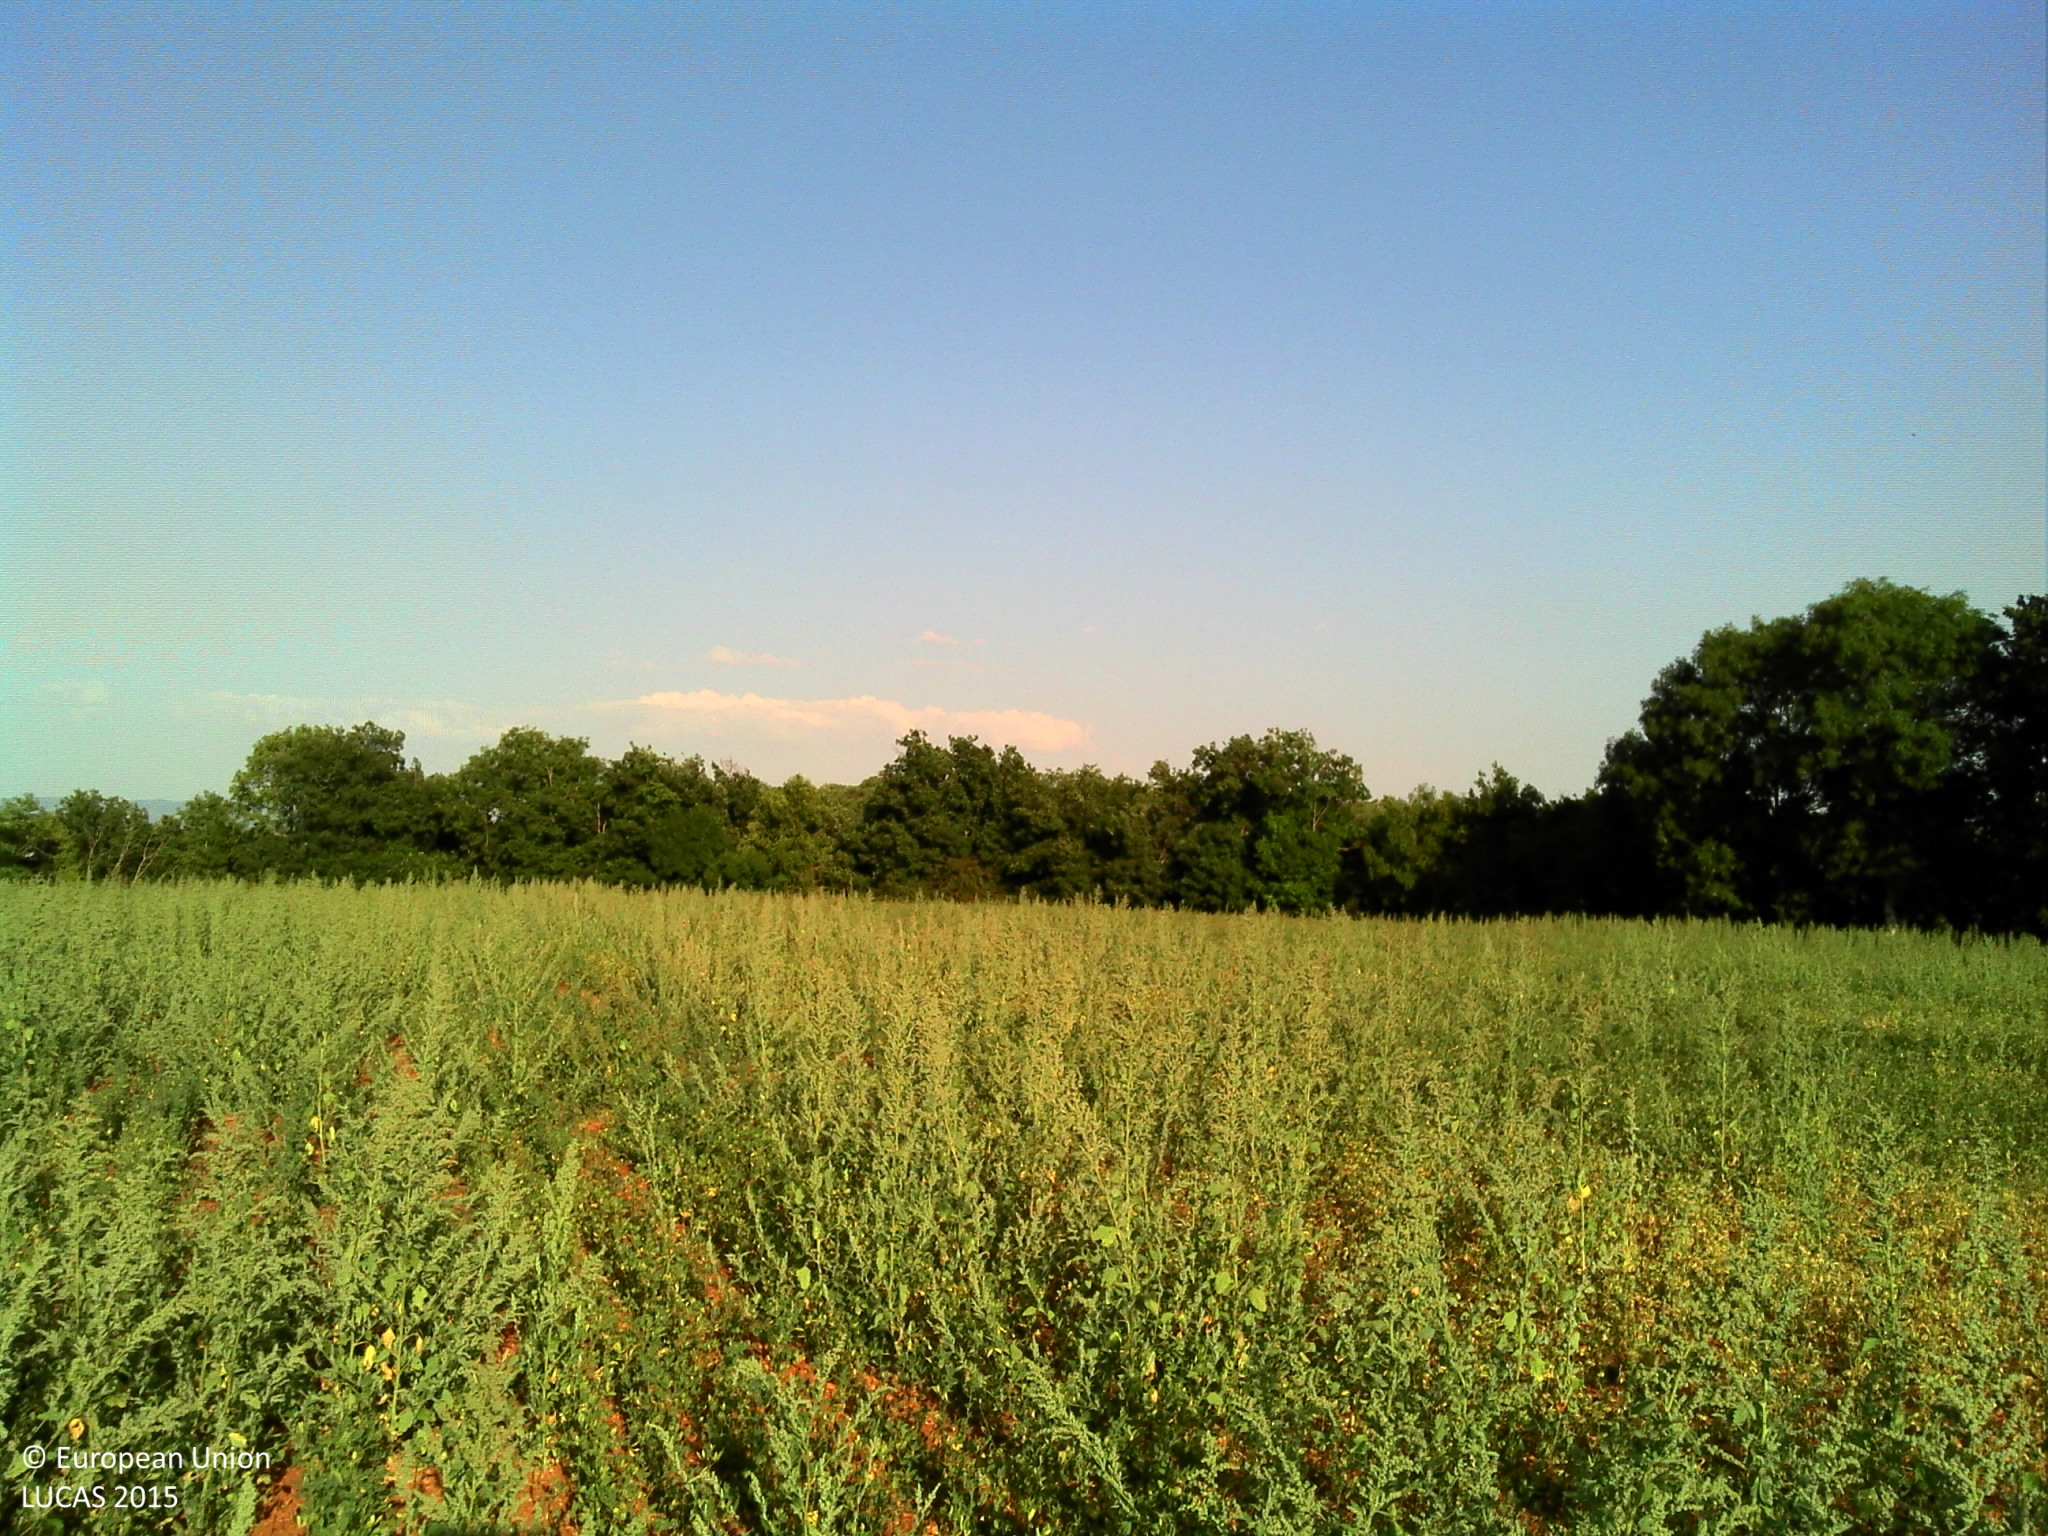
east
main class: Cropland
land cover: Lucerne
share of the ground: 50 - 75 %
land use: Agriculture (excluding fallow land and kitchen gardens)
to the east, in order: Lucerne; Broadleaved woodland
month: August
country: FR
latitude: 44.0127
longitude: 3.1084
